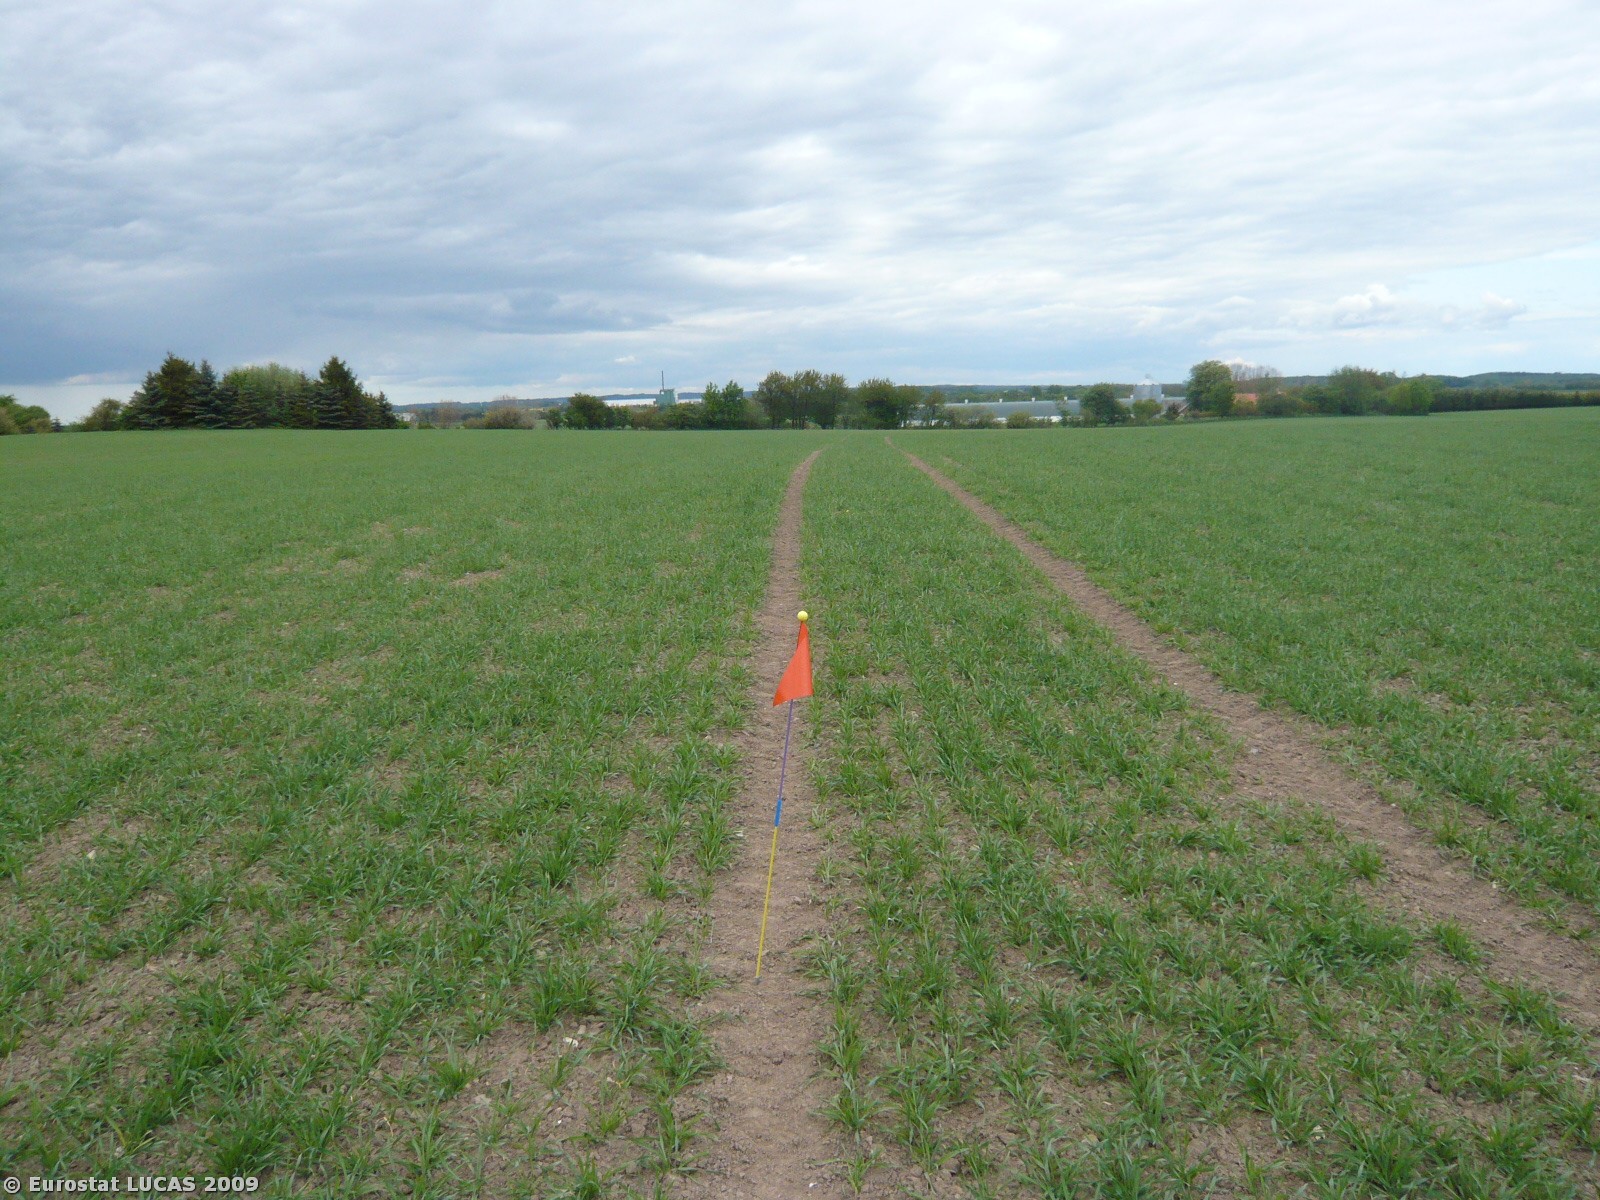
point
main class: Cropland
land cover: Common wheat
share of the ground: 25 - 50 %
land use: Agriculture (excluding fallow land and kitchen gardens)
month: May
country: DK
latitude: 55.0940
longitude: 11.9573
